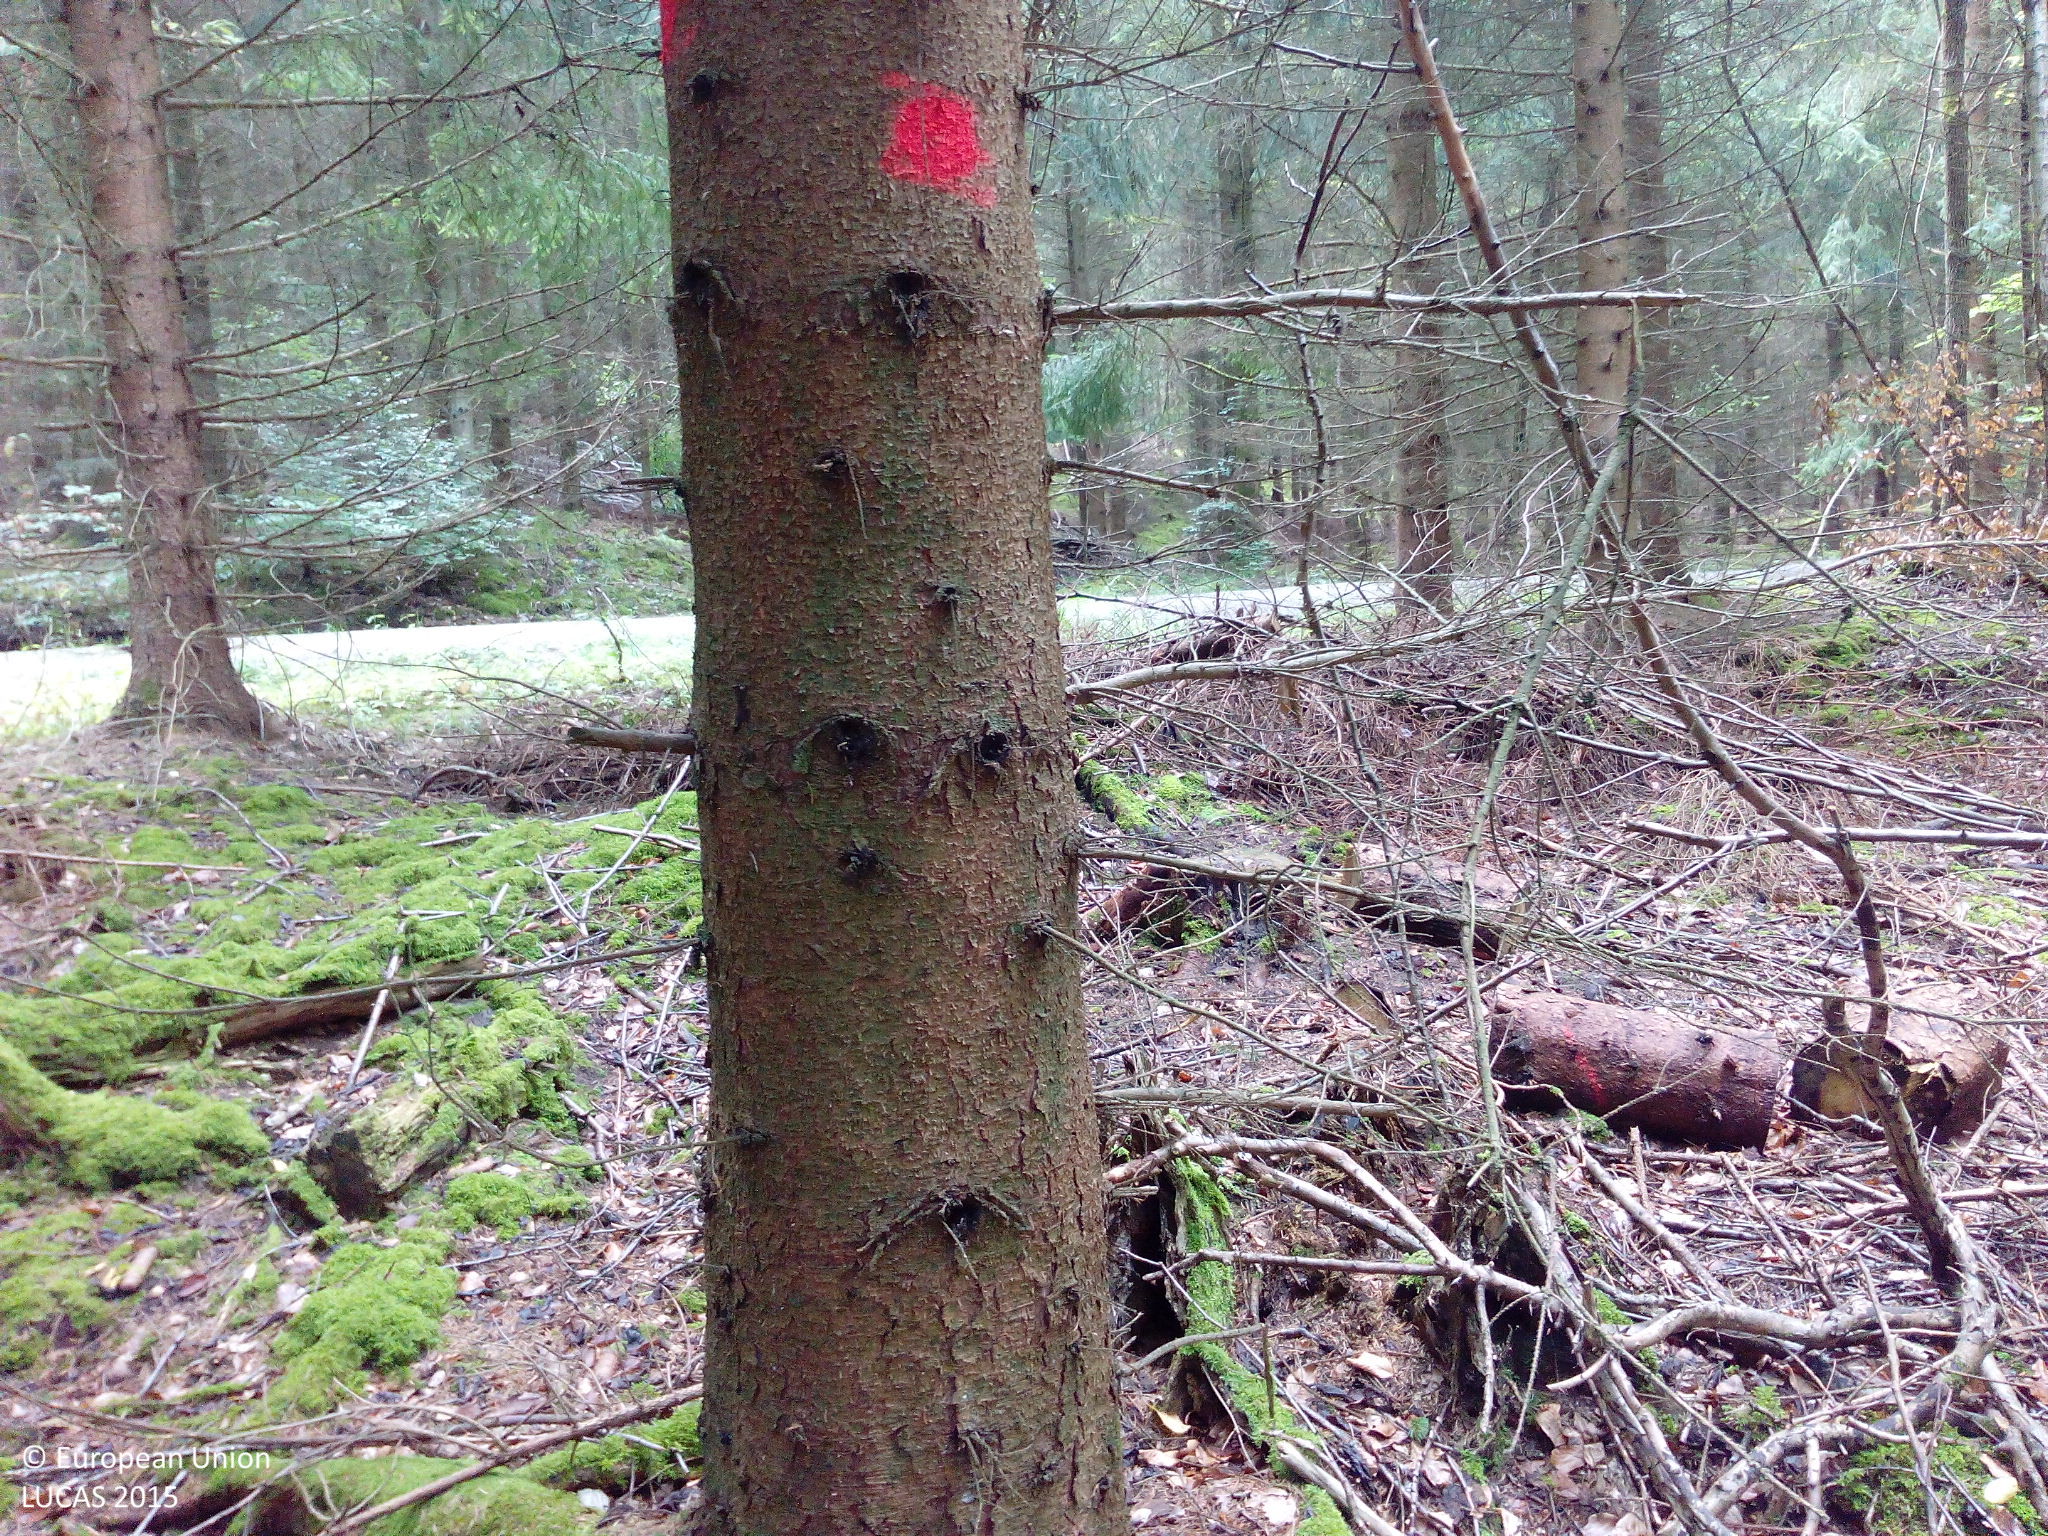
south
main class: Woodland
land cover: Spruce dominated mixed woodland
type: hemiboreal forest and nemoral coniferous forest and mixed broadleaved-coniferous forest
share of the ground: > 75 %
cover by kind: coniferous forest trees 50 %, broadleaved forest trees 25 %, unconsolidated bare surface 15 %, lichens and mosses 10 %
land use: Forestry
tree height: > 5 m
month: August
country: DE
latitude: 50.2750
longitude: 8.0219
